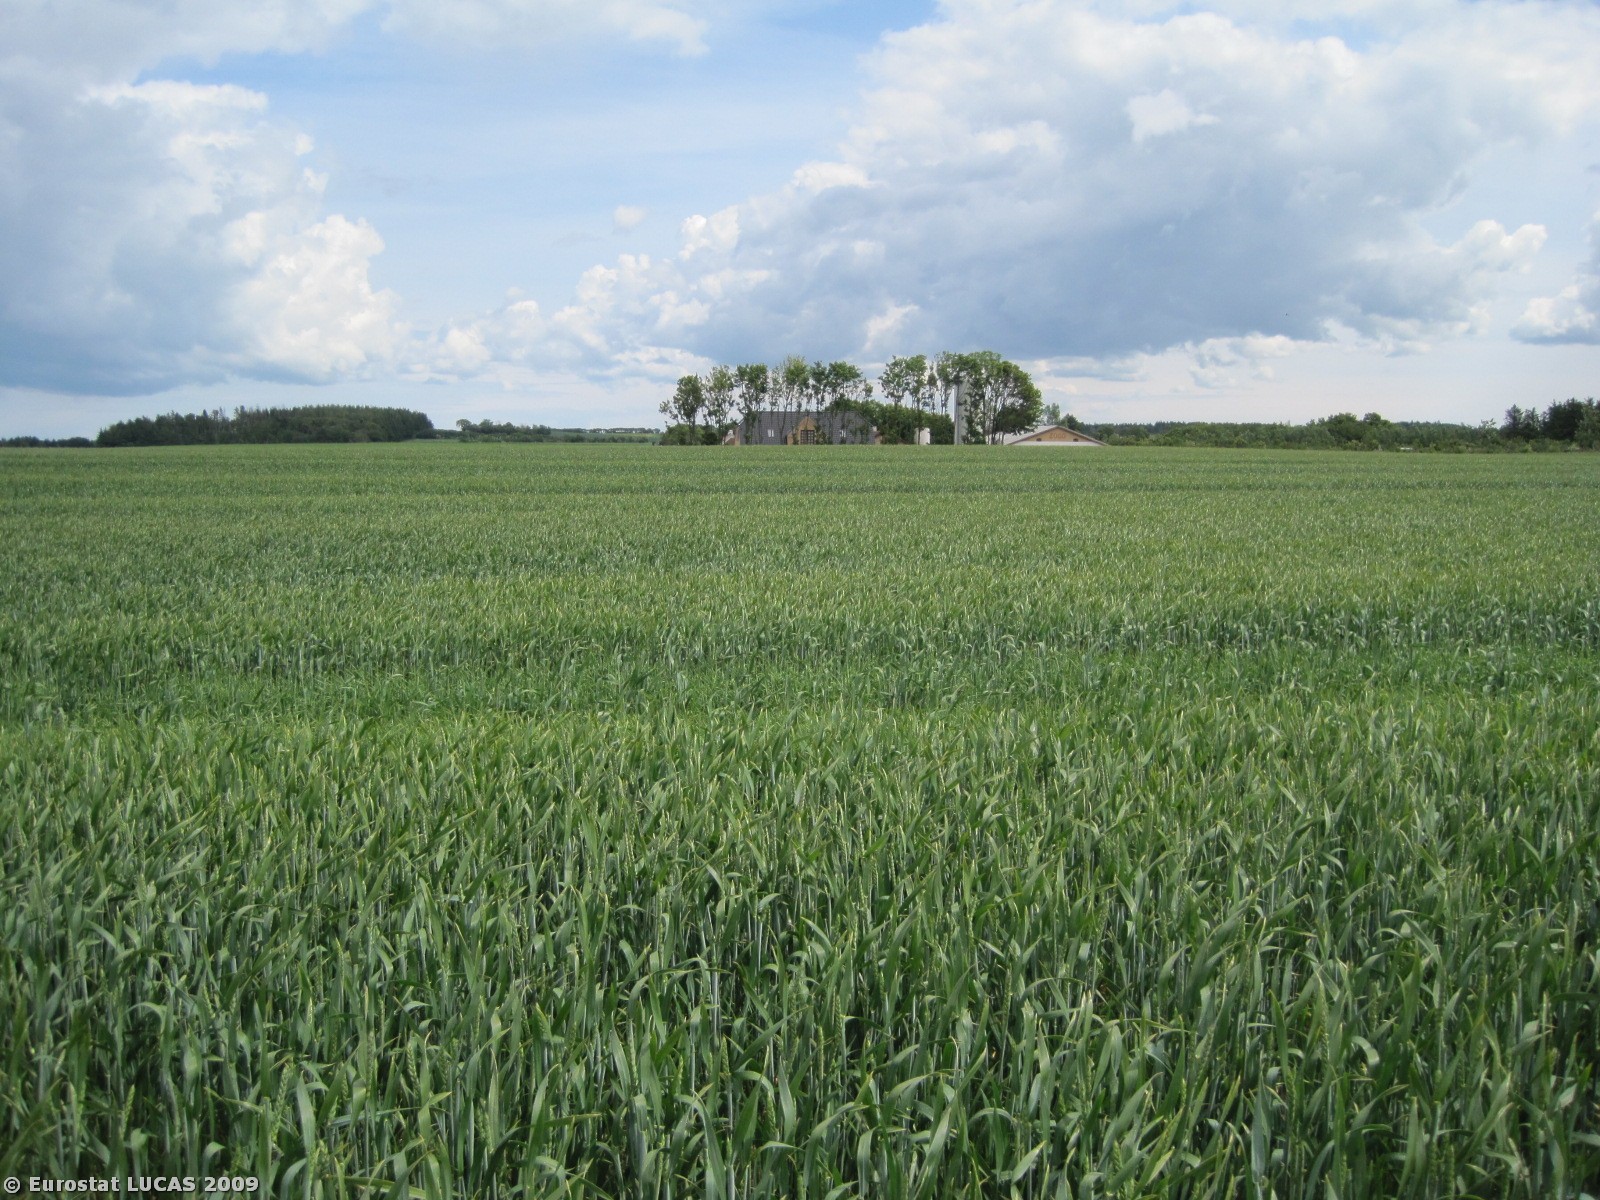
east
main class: Cropland
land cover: Common wheat
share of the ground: 50 - 75 %
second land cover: Barley
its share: 10 - 25 %
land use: Agriculture (excluding fallow land and kitchen gardens)
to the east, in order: Common wheat; Barley; Common wheat; Barley; Common wheat; Barley; Common wheat; Barley; Common wheat; Barley; Common wheat; Barley; Common wheat; Barley; Common wheat; Grass margins; Paved roads, cycling and walking lanes; Grassland without tree/shrub cover; Shrubland without tree cover; Broadleaved woodland; Grassland without tree/shrub cover; Artificial constructions in urban areas
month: June
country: DK
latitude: 57.3023
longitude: 9.8509
